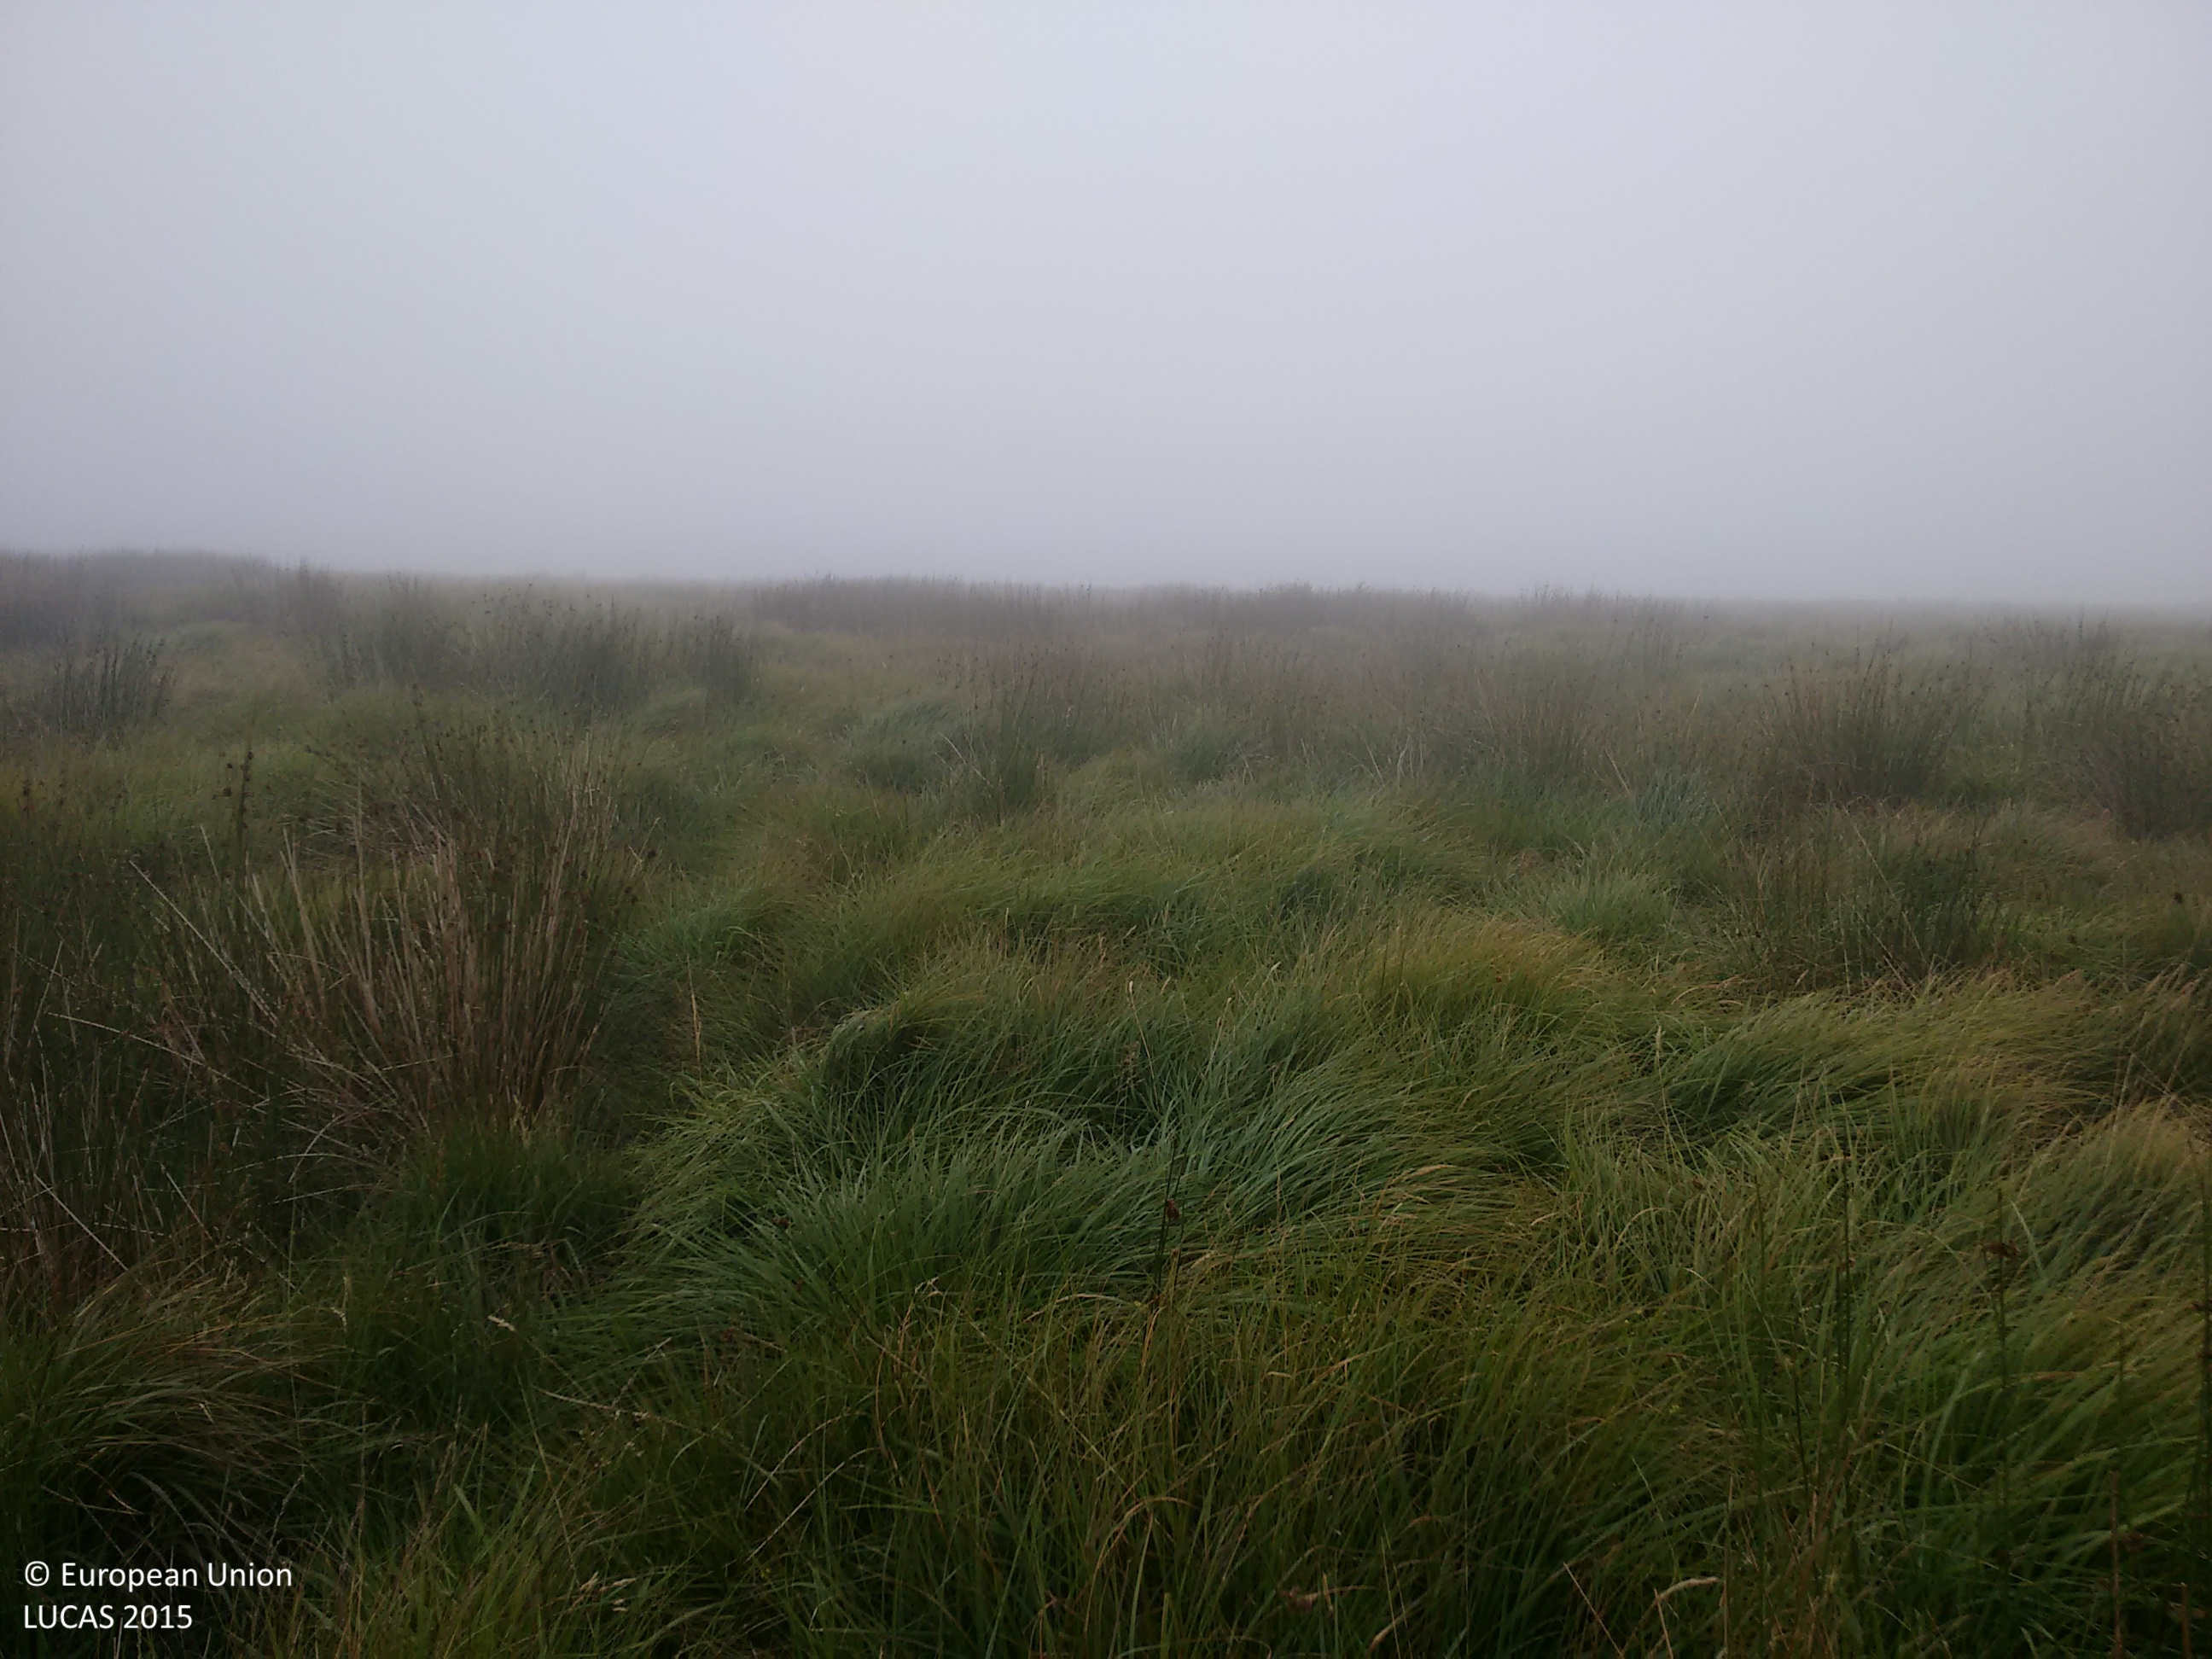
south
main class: Grassland
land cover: Grassland without tree/shrub cover
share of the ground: > 75 %
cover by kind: herbaceous plants 100 %
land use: Agriculture (excluding fallow land and kitchen gardens)
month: August
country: GB
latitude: 51.1114
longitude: -3.7884
